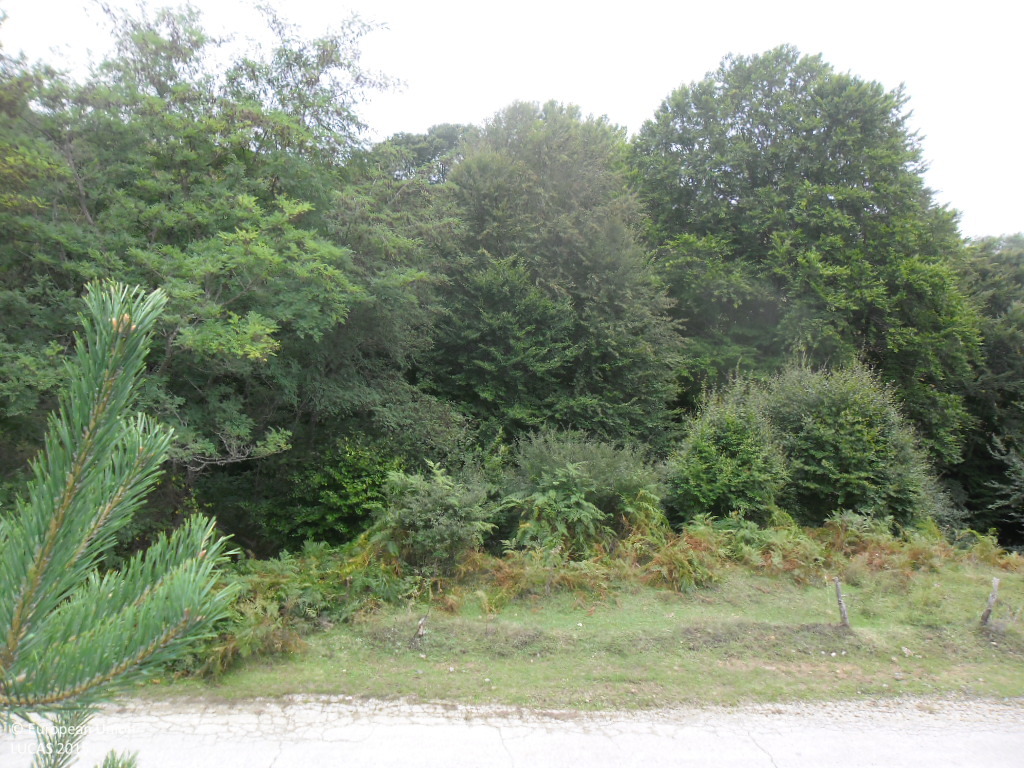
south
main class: Grassland
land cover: Grassland with sparse tree/shrub cover
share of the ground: > 75 %
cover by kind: herbaceous plants 90 %, broadleaved forest trees 5 %, shrubs 5 %
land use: Agriculture (excluding fallow land and kitchen gardens)
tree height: < 5 m
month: September
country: BG
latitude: 41.6125
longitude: 22.9909
